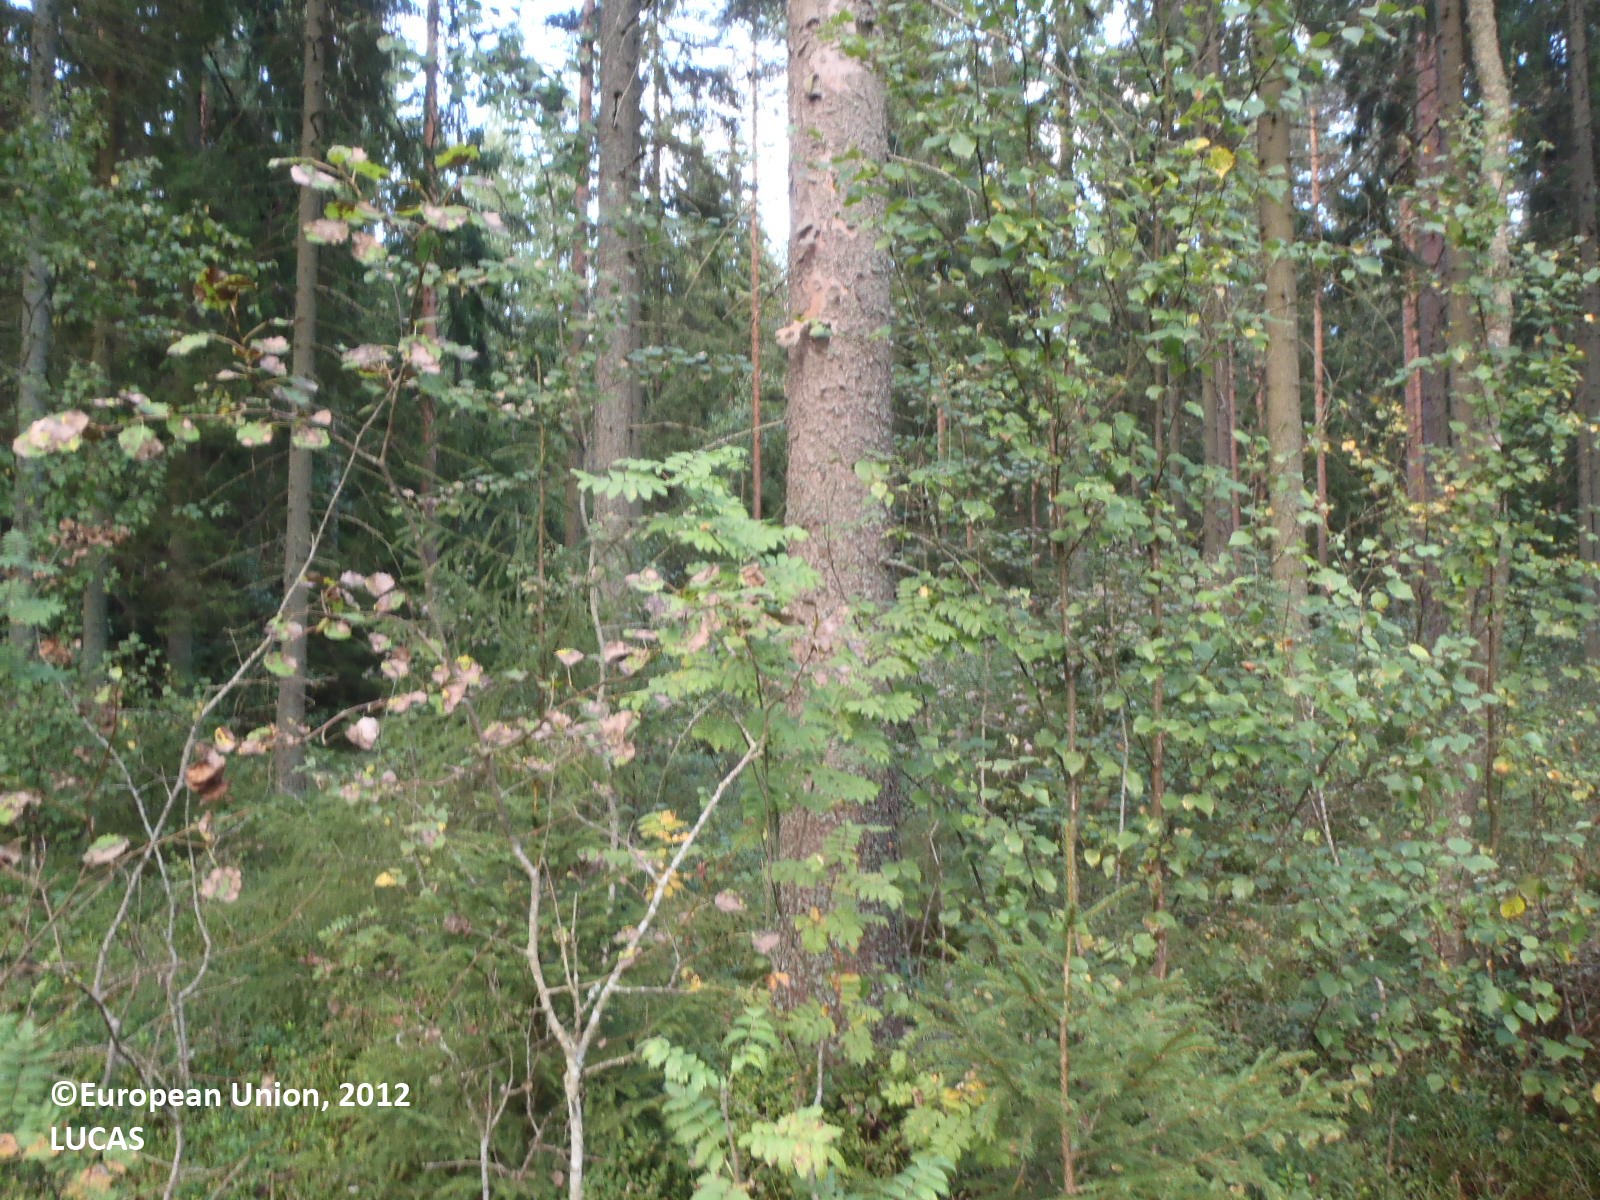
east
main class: Woodland
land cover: Other coniferous woodland
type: boreal forest
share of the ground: > 75 %
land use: Forestry
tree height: > 5 m
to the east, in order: Other coniferous woodland; Ditches and canals; Pine dominated coniferous woodland; Ditches and canals; Spruce dominated coniferous woodland; Ditches and canals; Spruce dominated coniferous woodland; Ditches and canals; Spruce dominated coniferous woodland; Pine dominated coniferous woodland
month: August
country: FI
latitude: 60.6023
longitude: 22.3585
